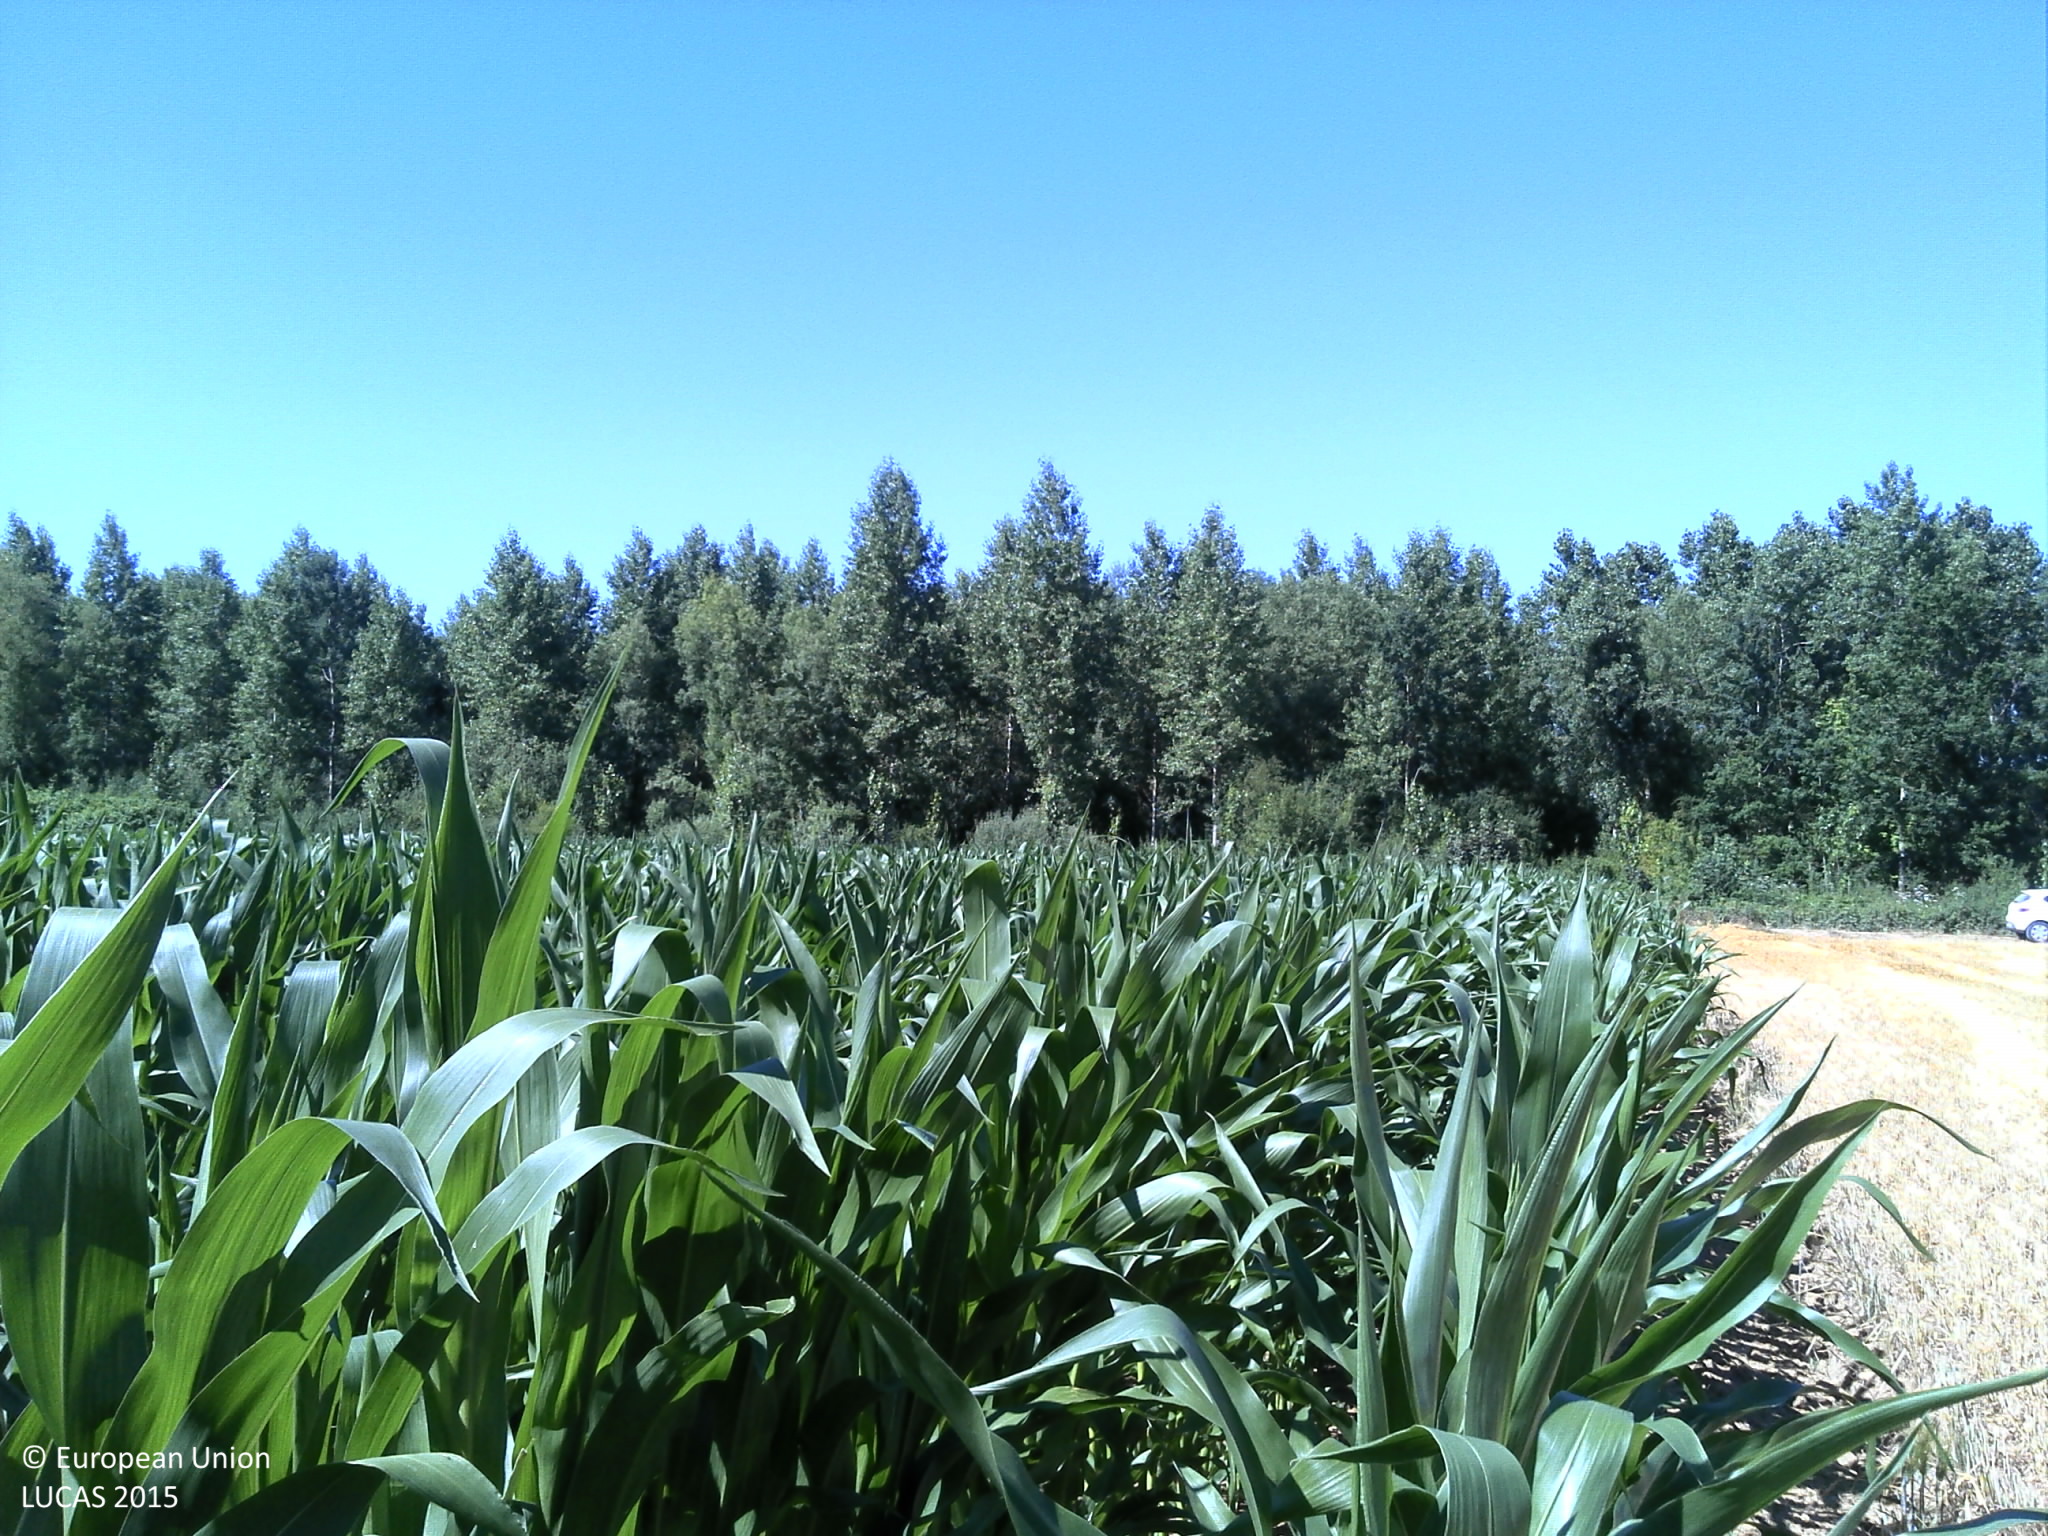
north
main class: Cropland
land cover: Maize
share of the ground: > 75 %
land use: Agriculture (excluding fallow land and kitchen gardens)
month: July
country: FR
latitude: 49.5065
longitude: 4.7907
